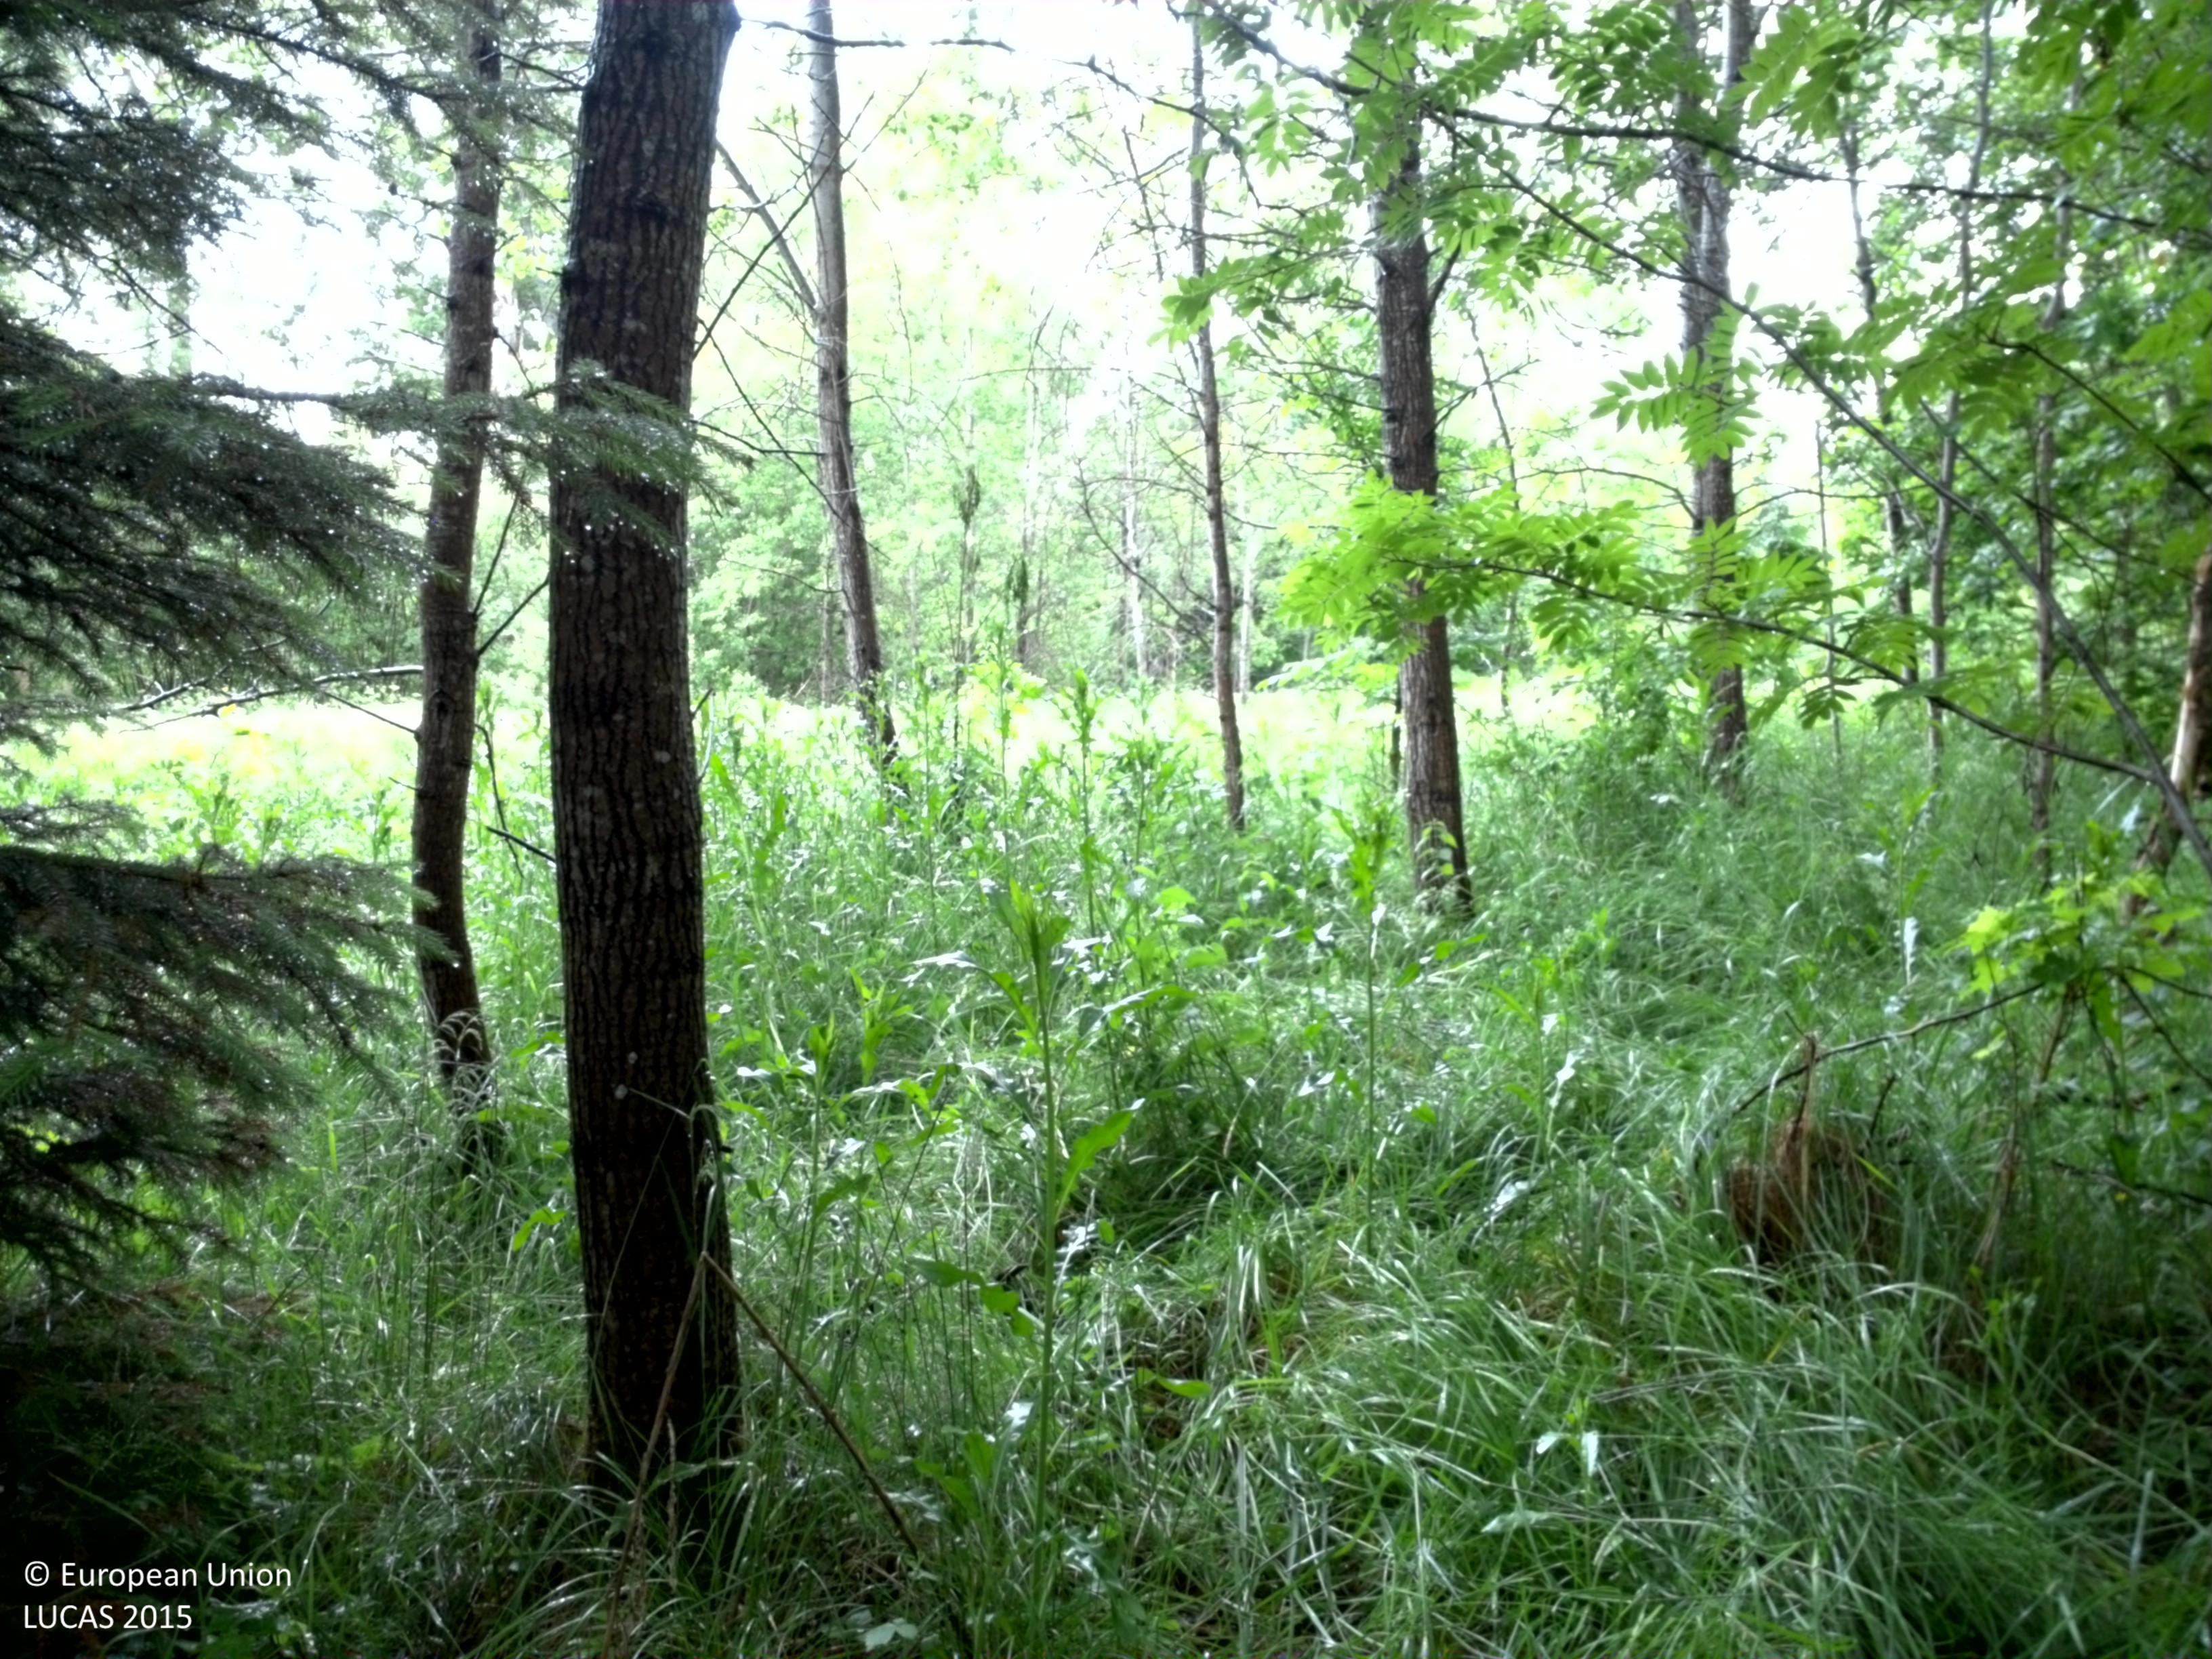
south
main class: Woodland
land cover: Broadleaved woodland
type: acidophilous oak and oak-birch forest
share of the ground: > 75 %
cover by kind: broadleaved forest trees 85 %, herbaceous plants 15 %
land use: Forestry
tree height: > 5 m
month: June
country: SE
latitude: 58.7243
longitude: 15.3987
